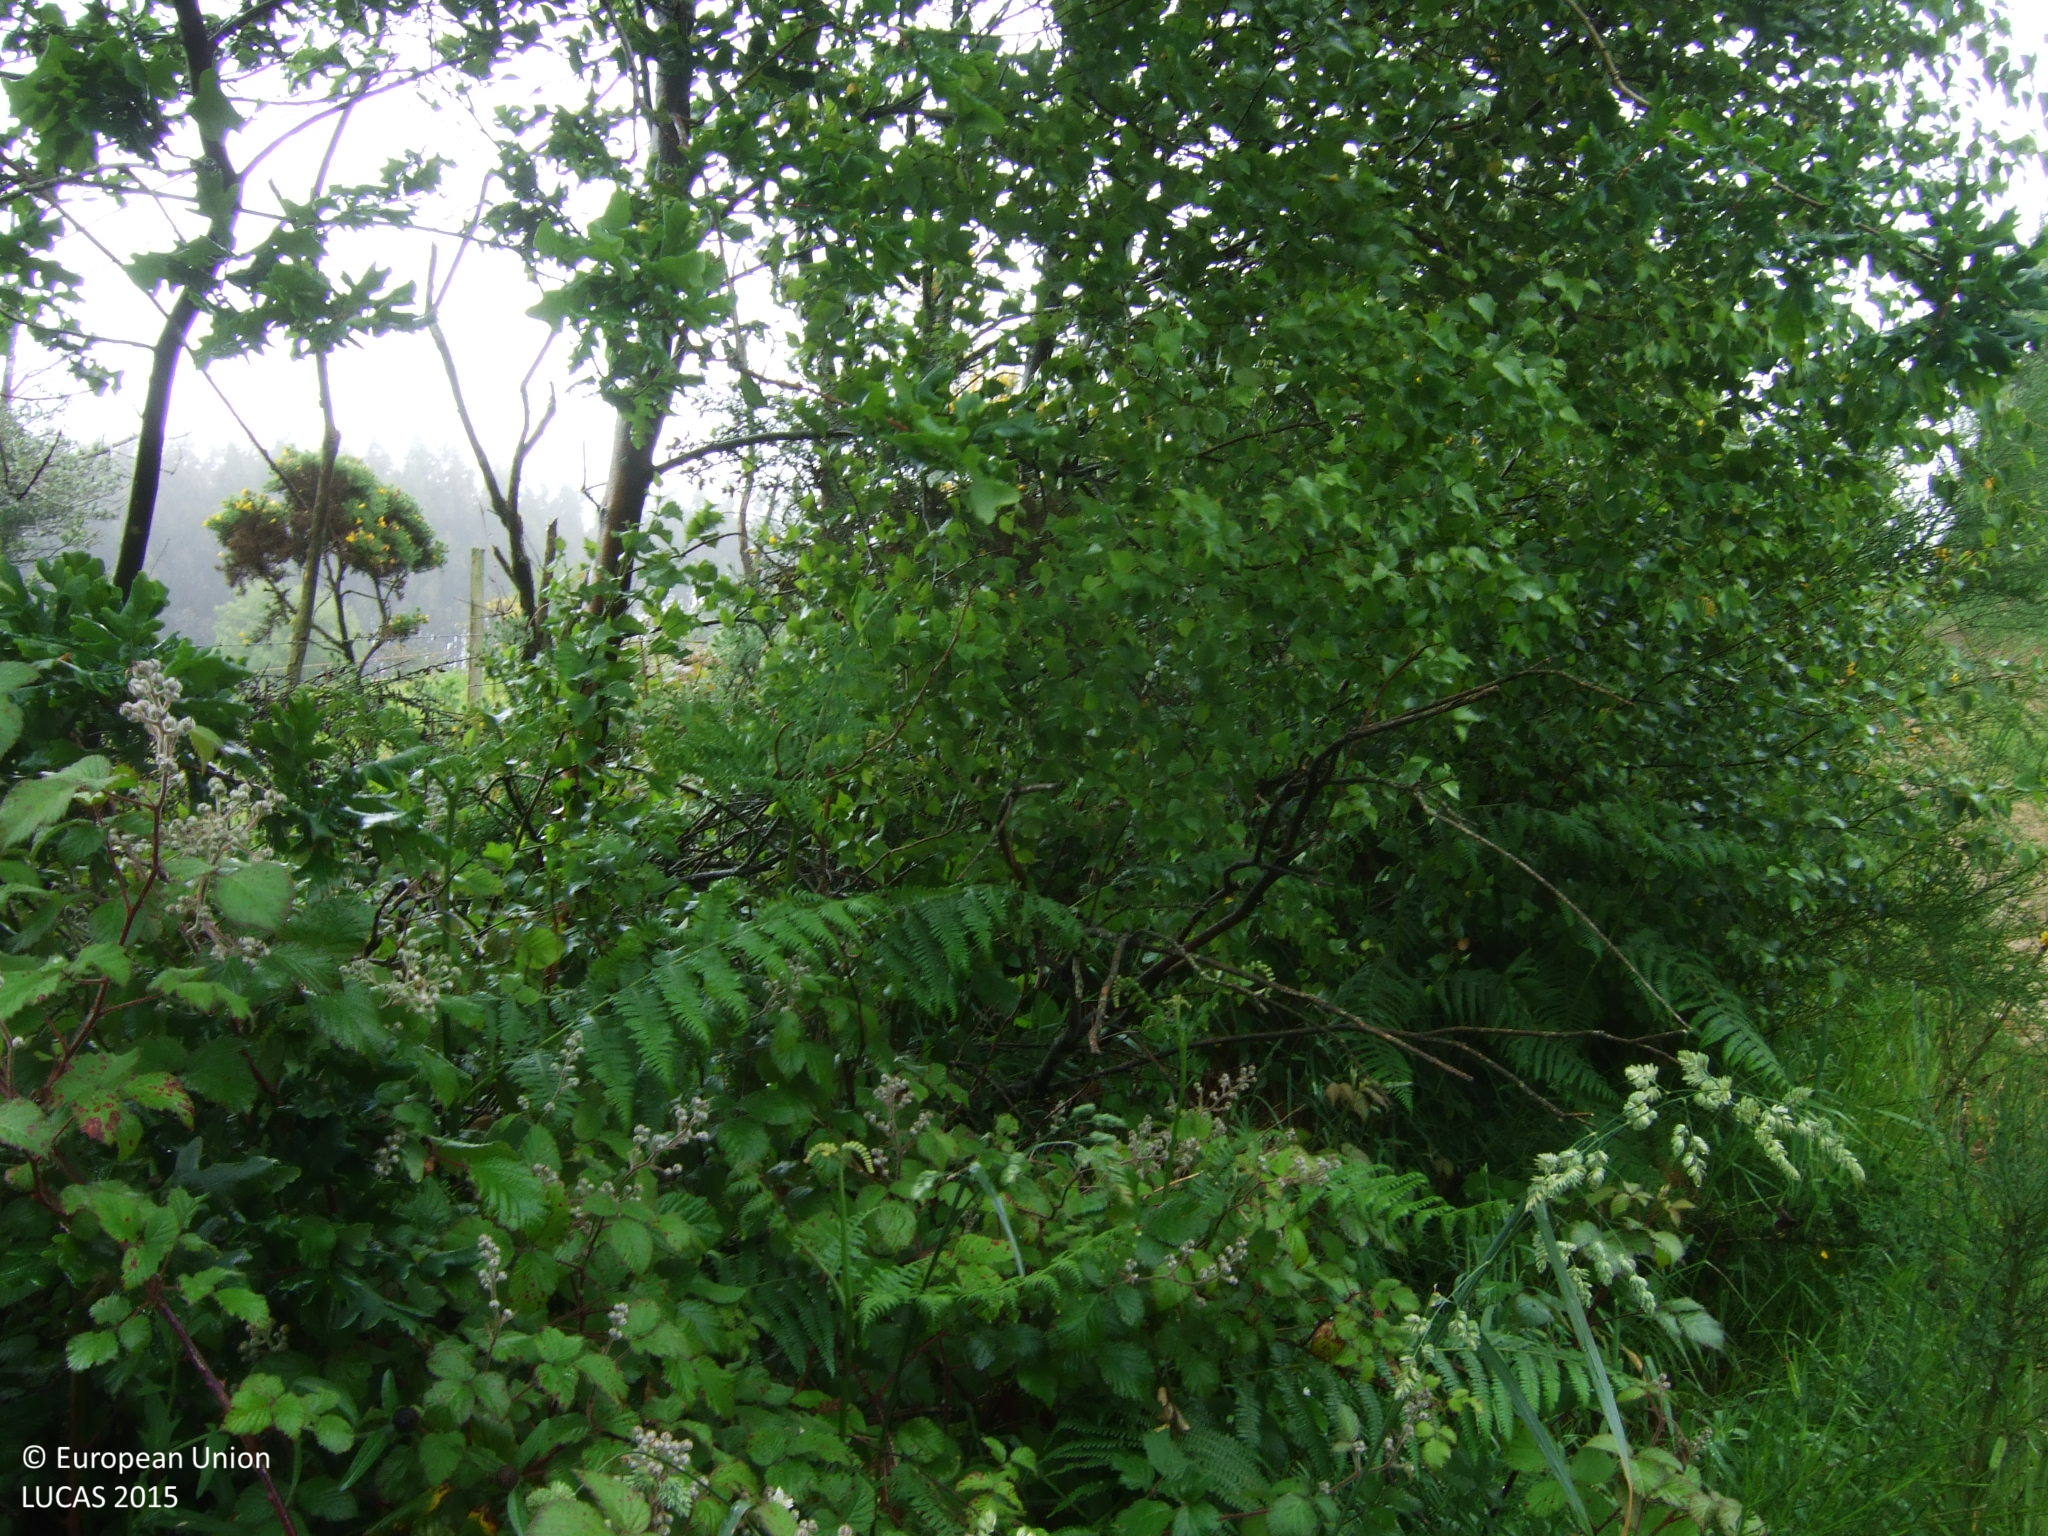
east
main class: Woodland
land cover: Pine dominated mixed woodland
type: exotic forest
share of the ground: 50 - 75 %
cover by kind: coniferous forest trees 40 %, shrubs 35 %, broadleaved forest trees 25 %
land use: Forestry
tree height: > 5 m
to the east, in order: Pine dominated mixed woodland; Tracks; Shruby margins; Grassland without tree/shrub cover; Shruby margins; Tracks; Fences; Broadleaved woodland
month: June
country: ES
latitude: 43.3448
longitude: -7.5107
